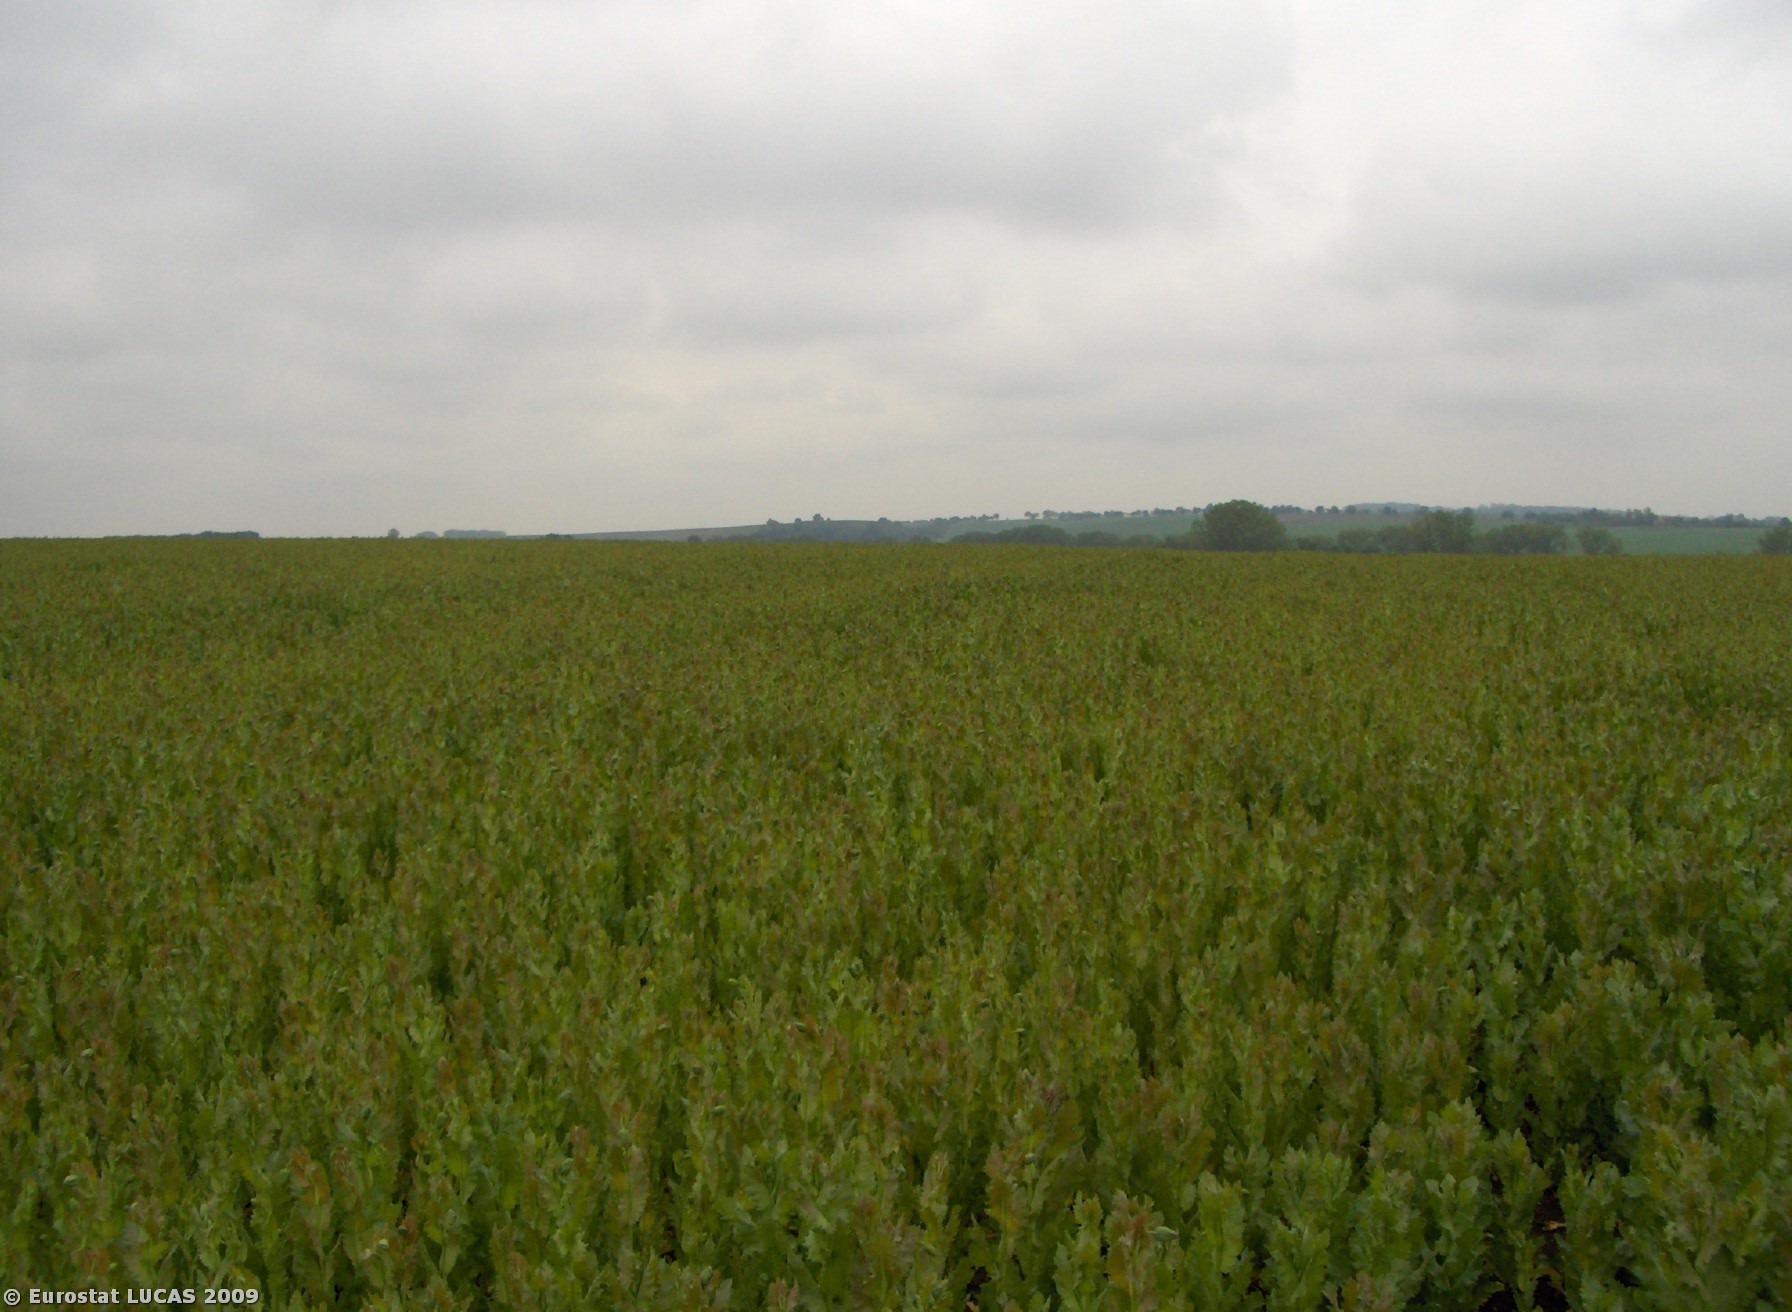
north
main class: Cropland
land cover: Other fibre and oleaginous crops
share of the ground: > 75 %
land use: Agriculture (excluding fallow land and kitchen gardens)
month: May
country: CZ
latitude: 49.3634
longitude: 17.1565
